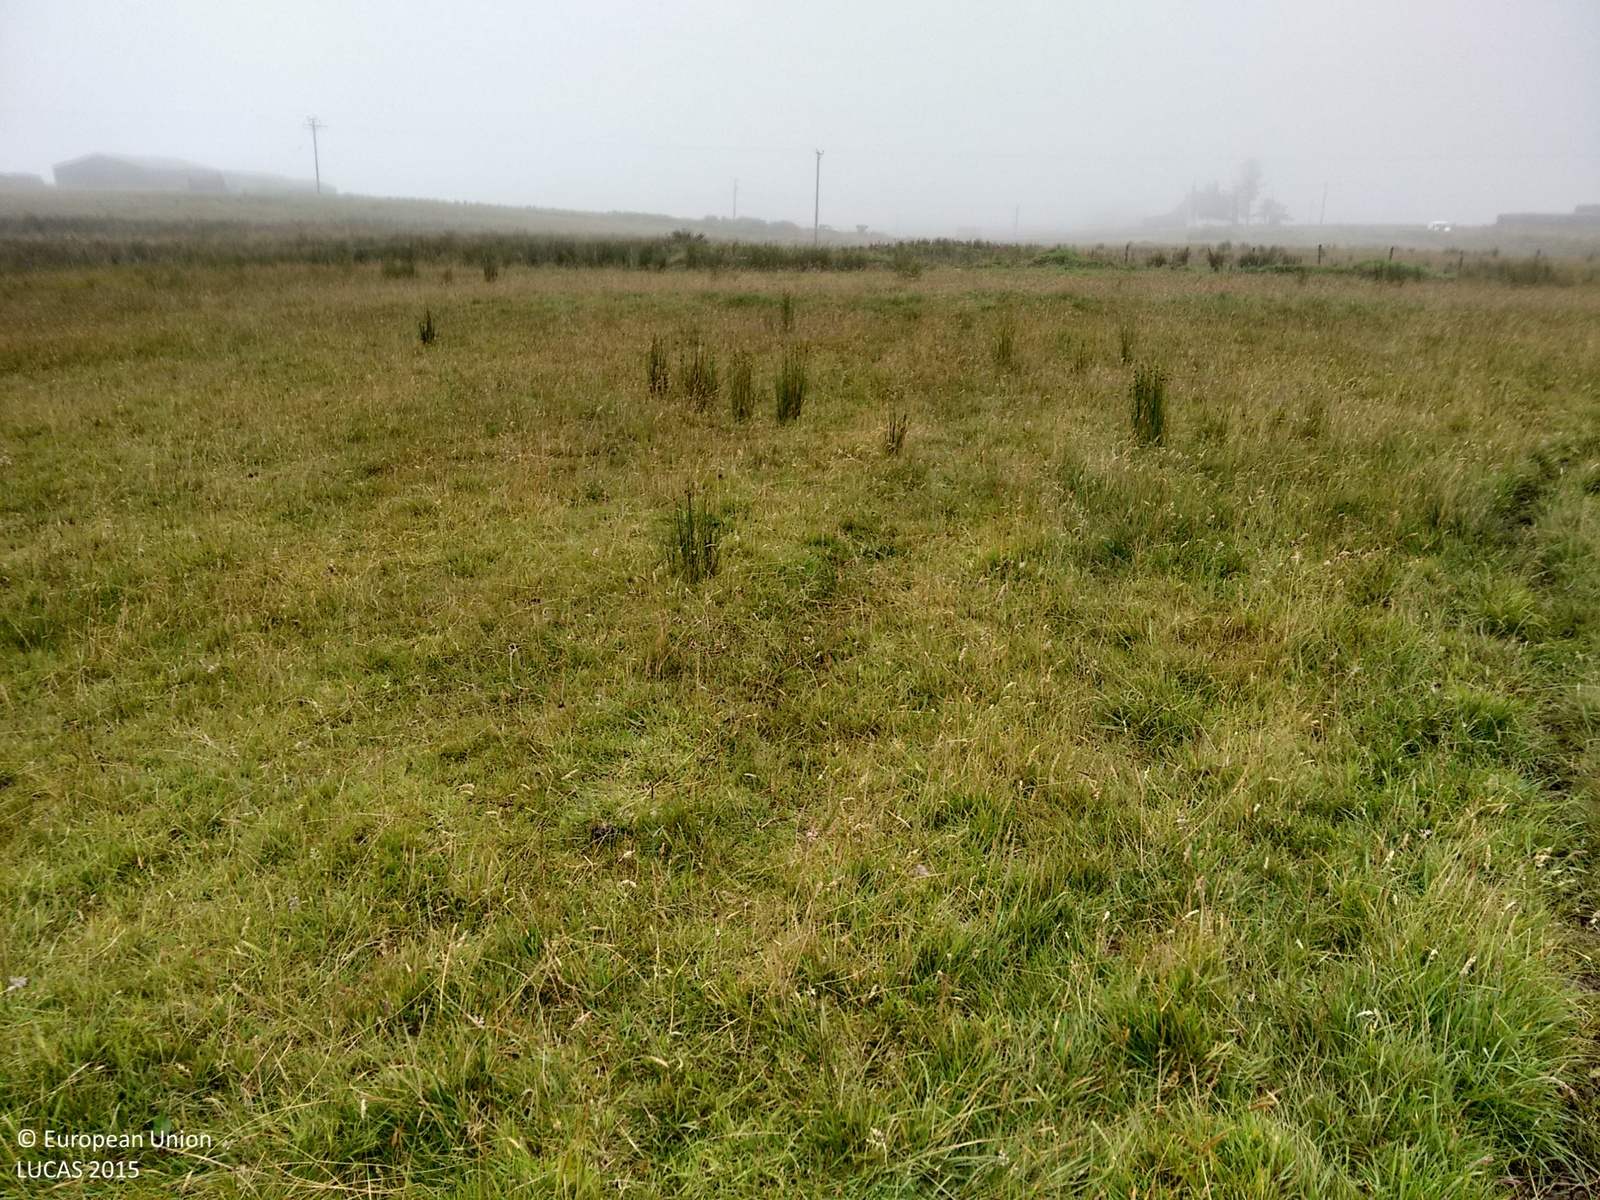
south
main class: Grassland
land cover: Grassland without tree/shrub cover
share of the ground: > 75 %
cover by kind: herbaceous plants 100 %
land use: Agriculture (excluding fallow land and kitchen gardens)
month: August
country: GB
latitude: 58.3259
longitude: -3.2600
